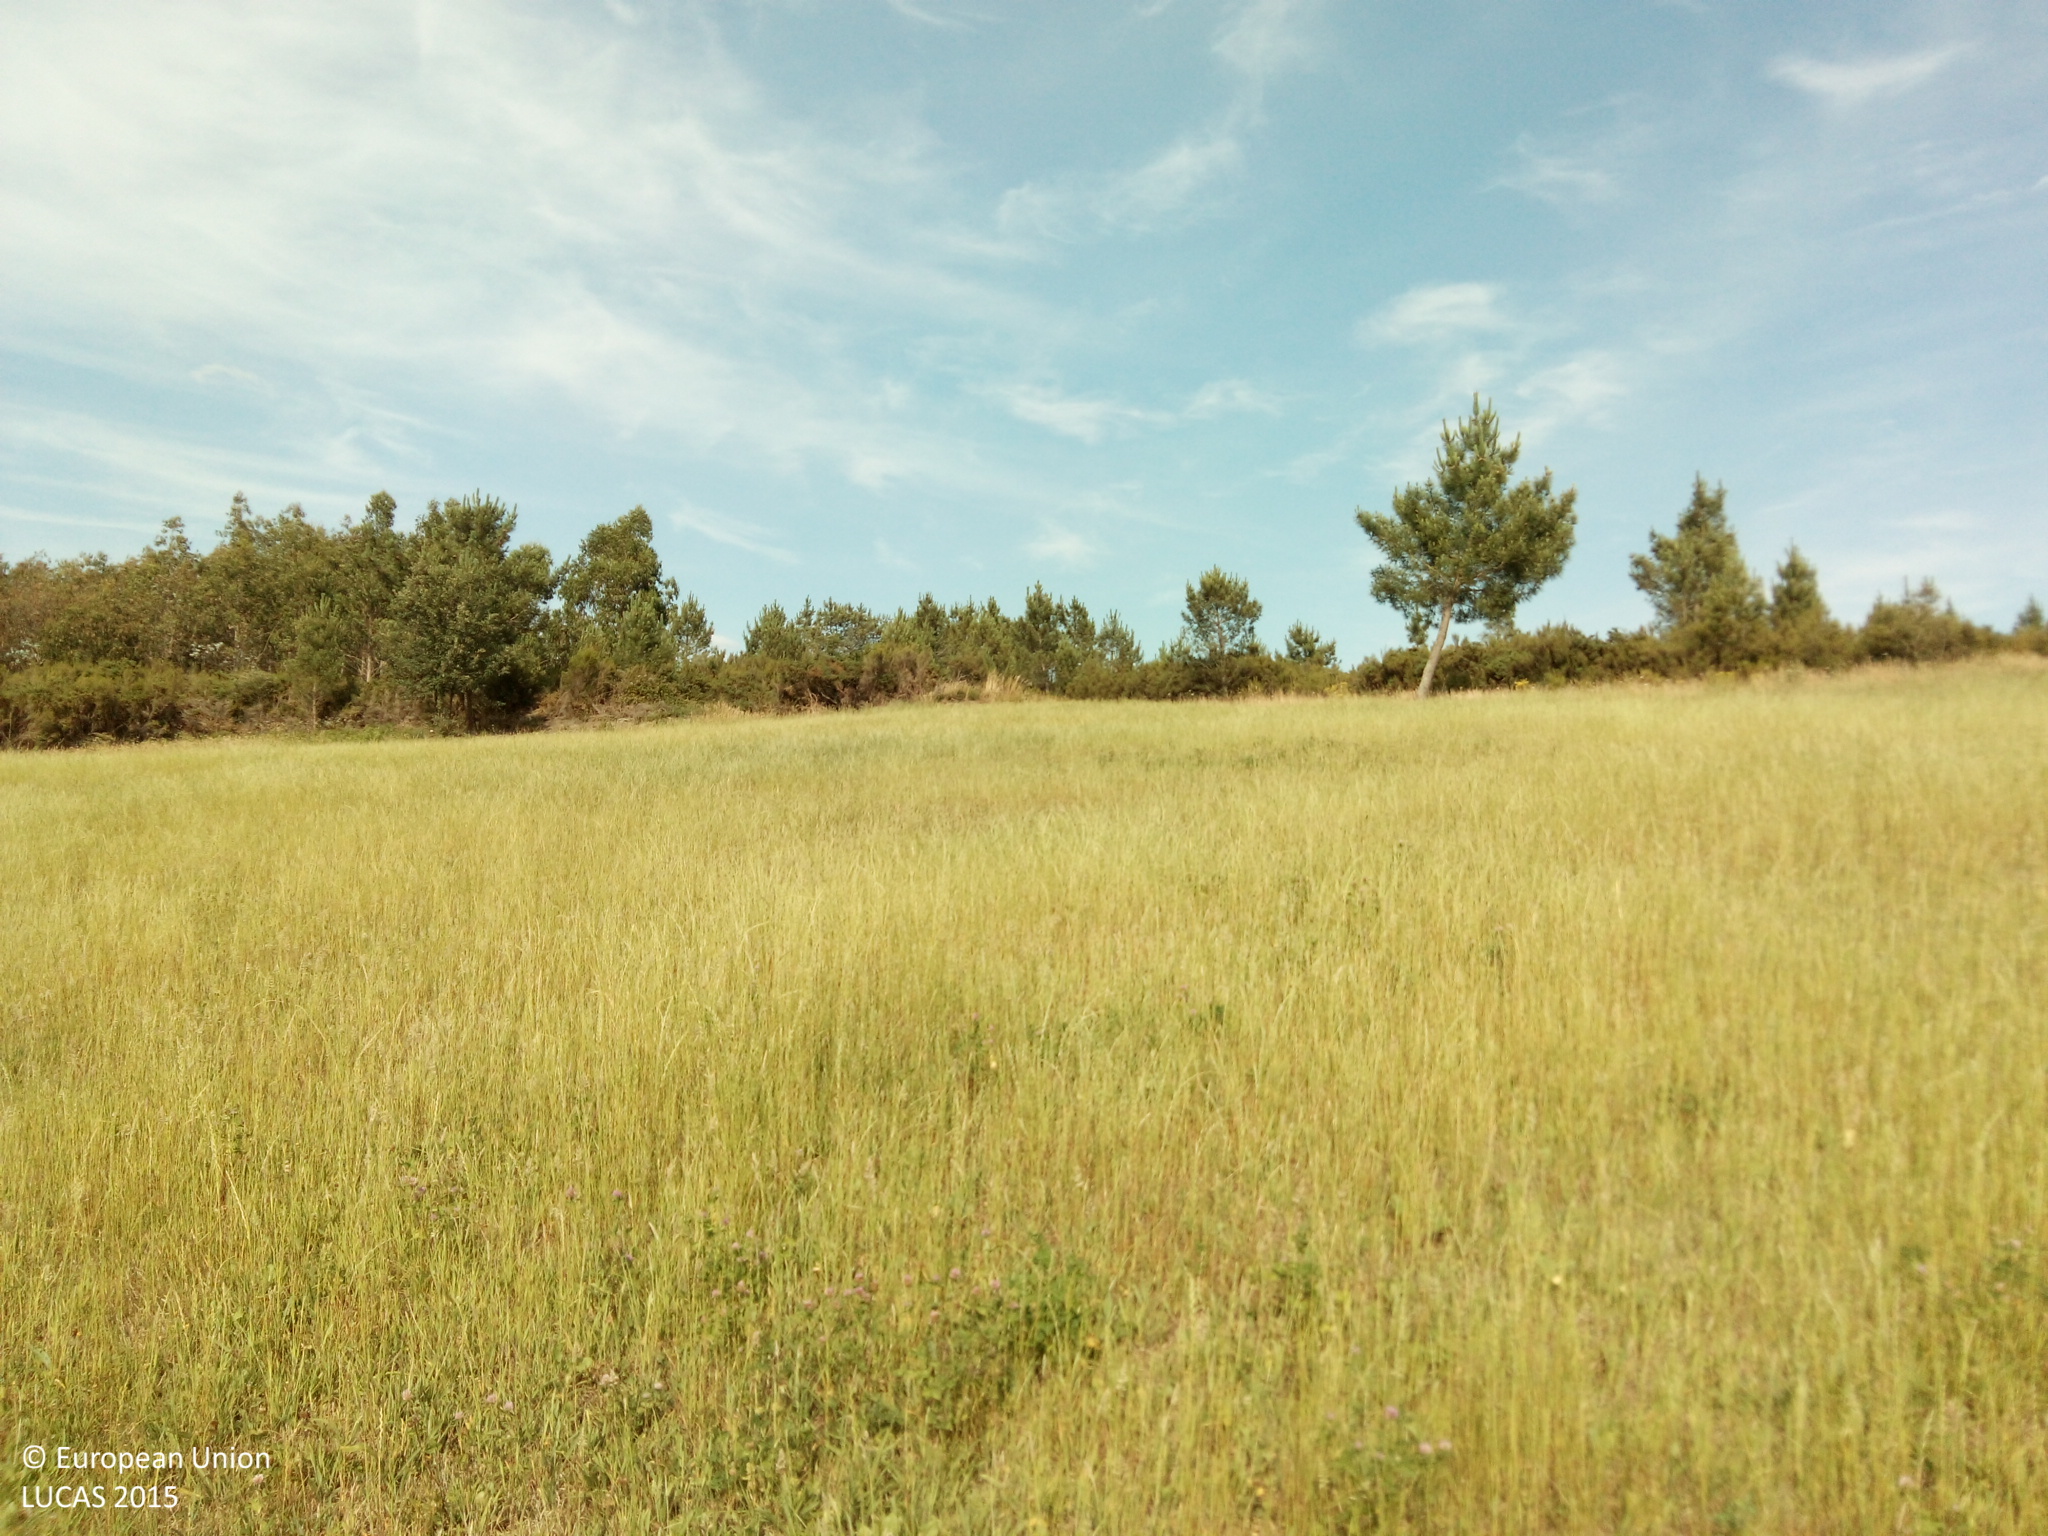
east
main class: Cropland
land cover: Mixed cereals for fodder
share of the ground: > 75 %
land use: Agriculture (excluding fallow land and kitchen gardens)
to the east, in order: Mixed cereals for fodder; Ditches and canals; Tracks; Ditches and canals; Shrubland with sparse tree cover; Grassland without tree/shrub cover; Pine dominated coniferous woodland
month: July
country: ES
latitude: 42.8717
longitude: -7.9971
